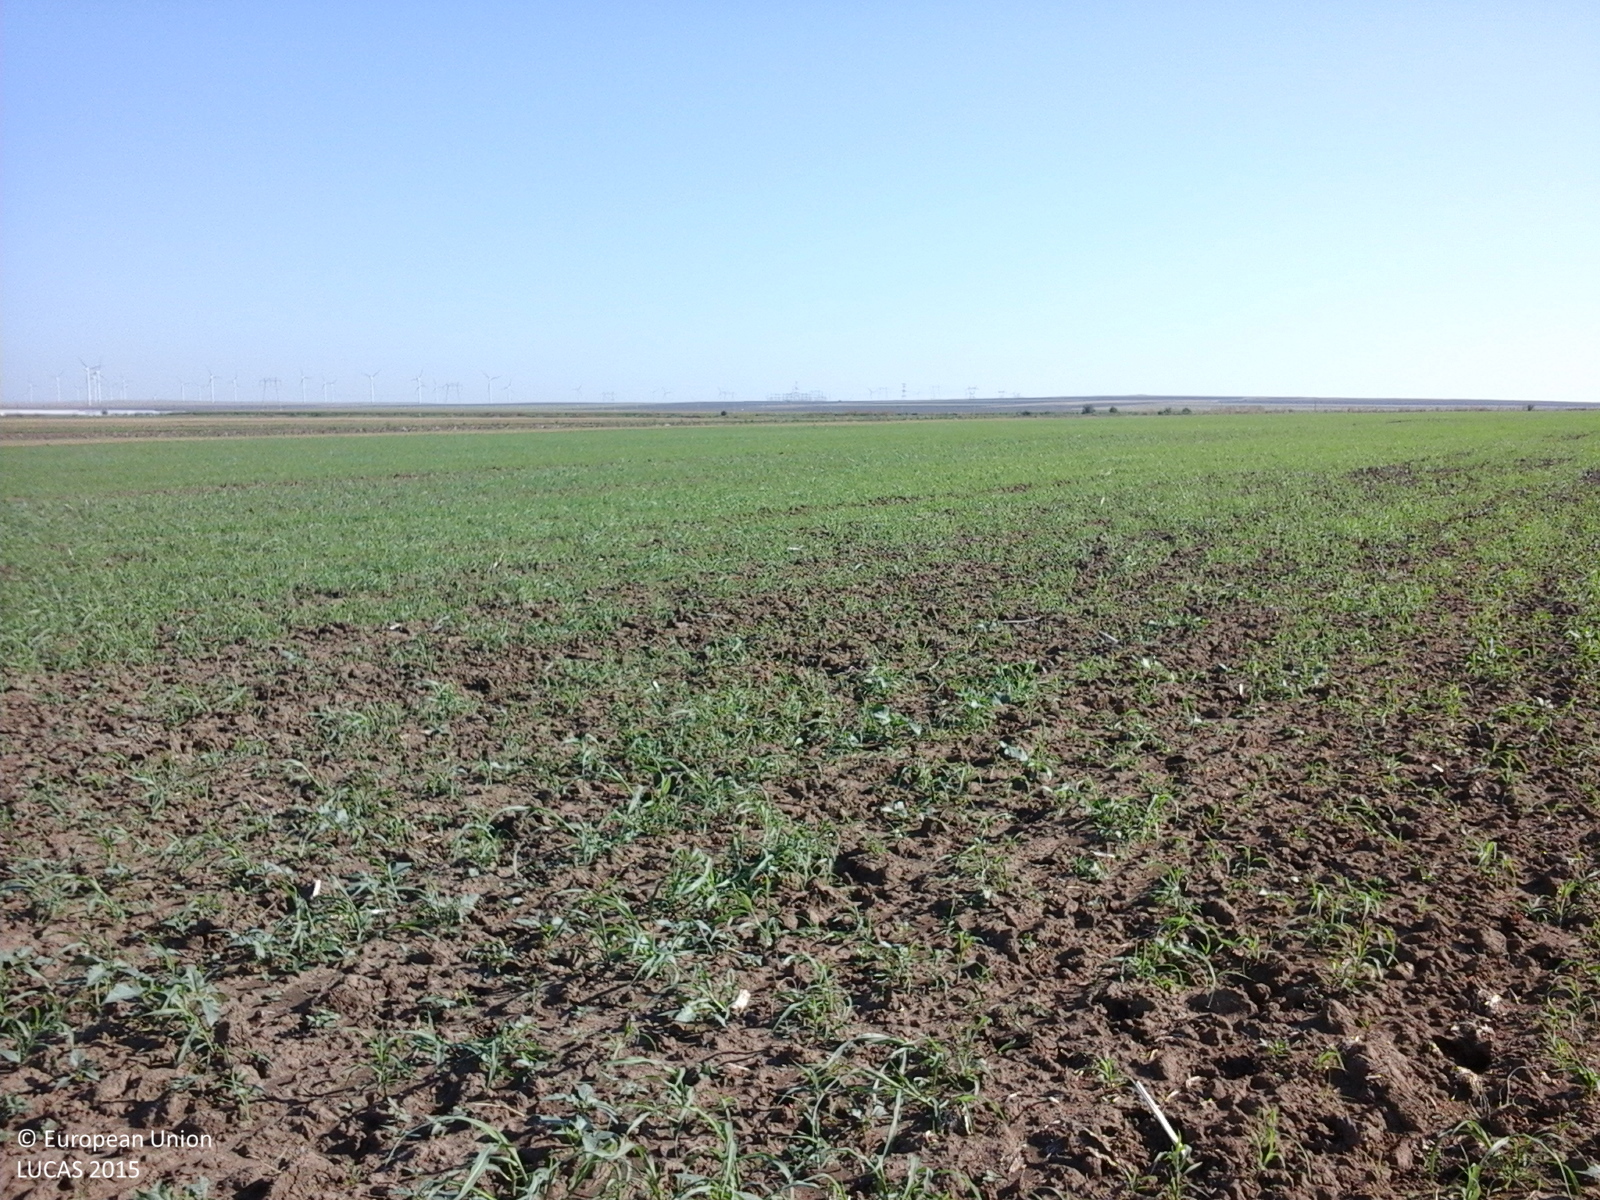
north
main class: Grassland
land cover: Spontaneously vegetated surfaces
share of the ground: > 75 %
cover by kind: herbaceous plants 100 %
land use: Agriculture (excluding fallow land and kitchen gardens)
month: August
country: RO
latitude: 44.5496
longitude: 28.6192
